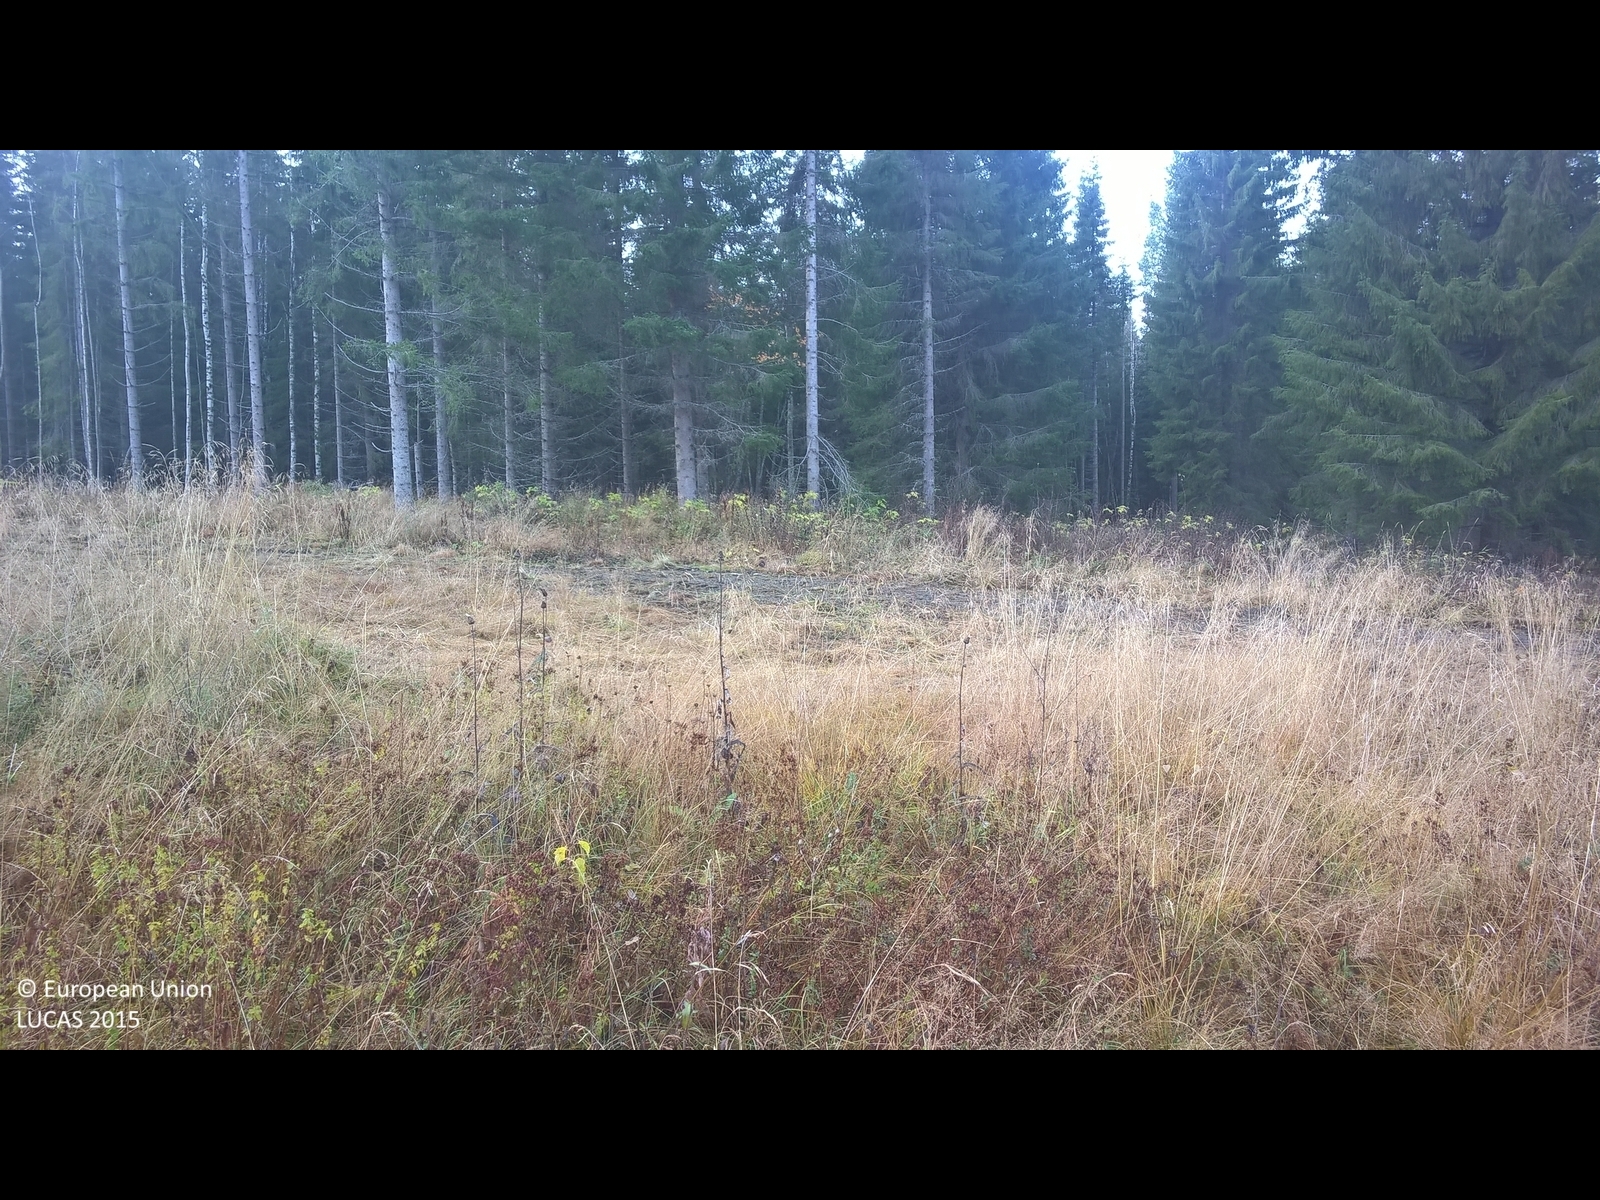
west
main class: Grassland
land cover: Spontaneously vegetated surfaces
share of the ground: > 75 %
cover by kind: herbaceous plants 100 %
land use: Forestry
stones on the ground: < 10 %
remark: Clear cut
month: October
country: SE
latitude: 63.2325
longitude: 15.0524
